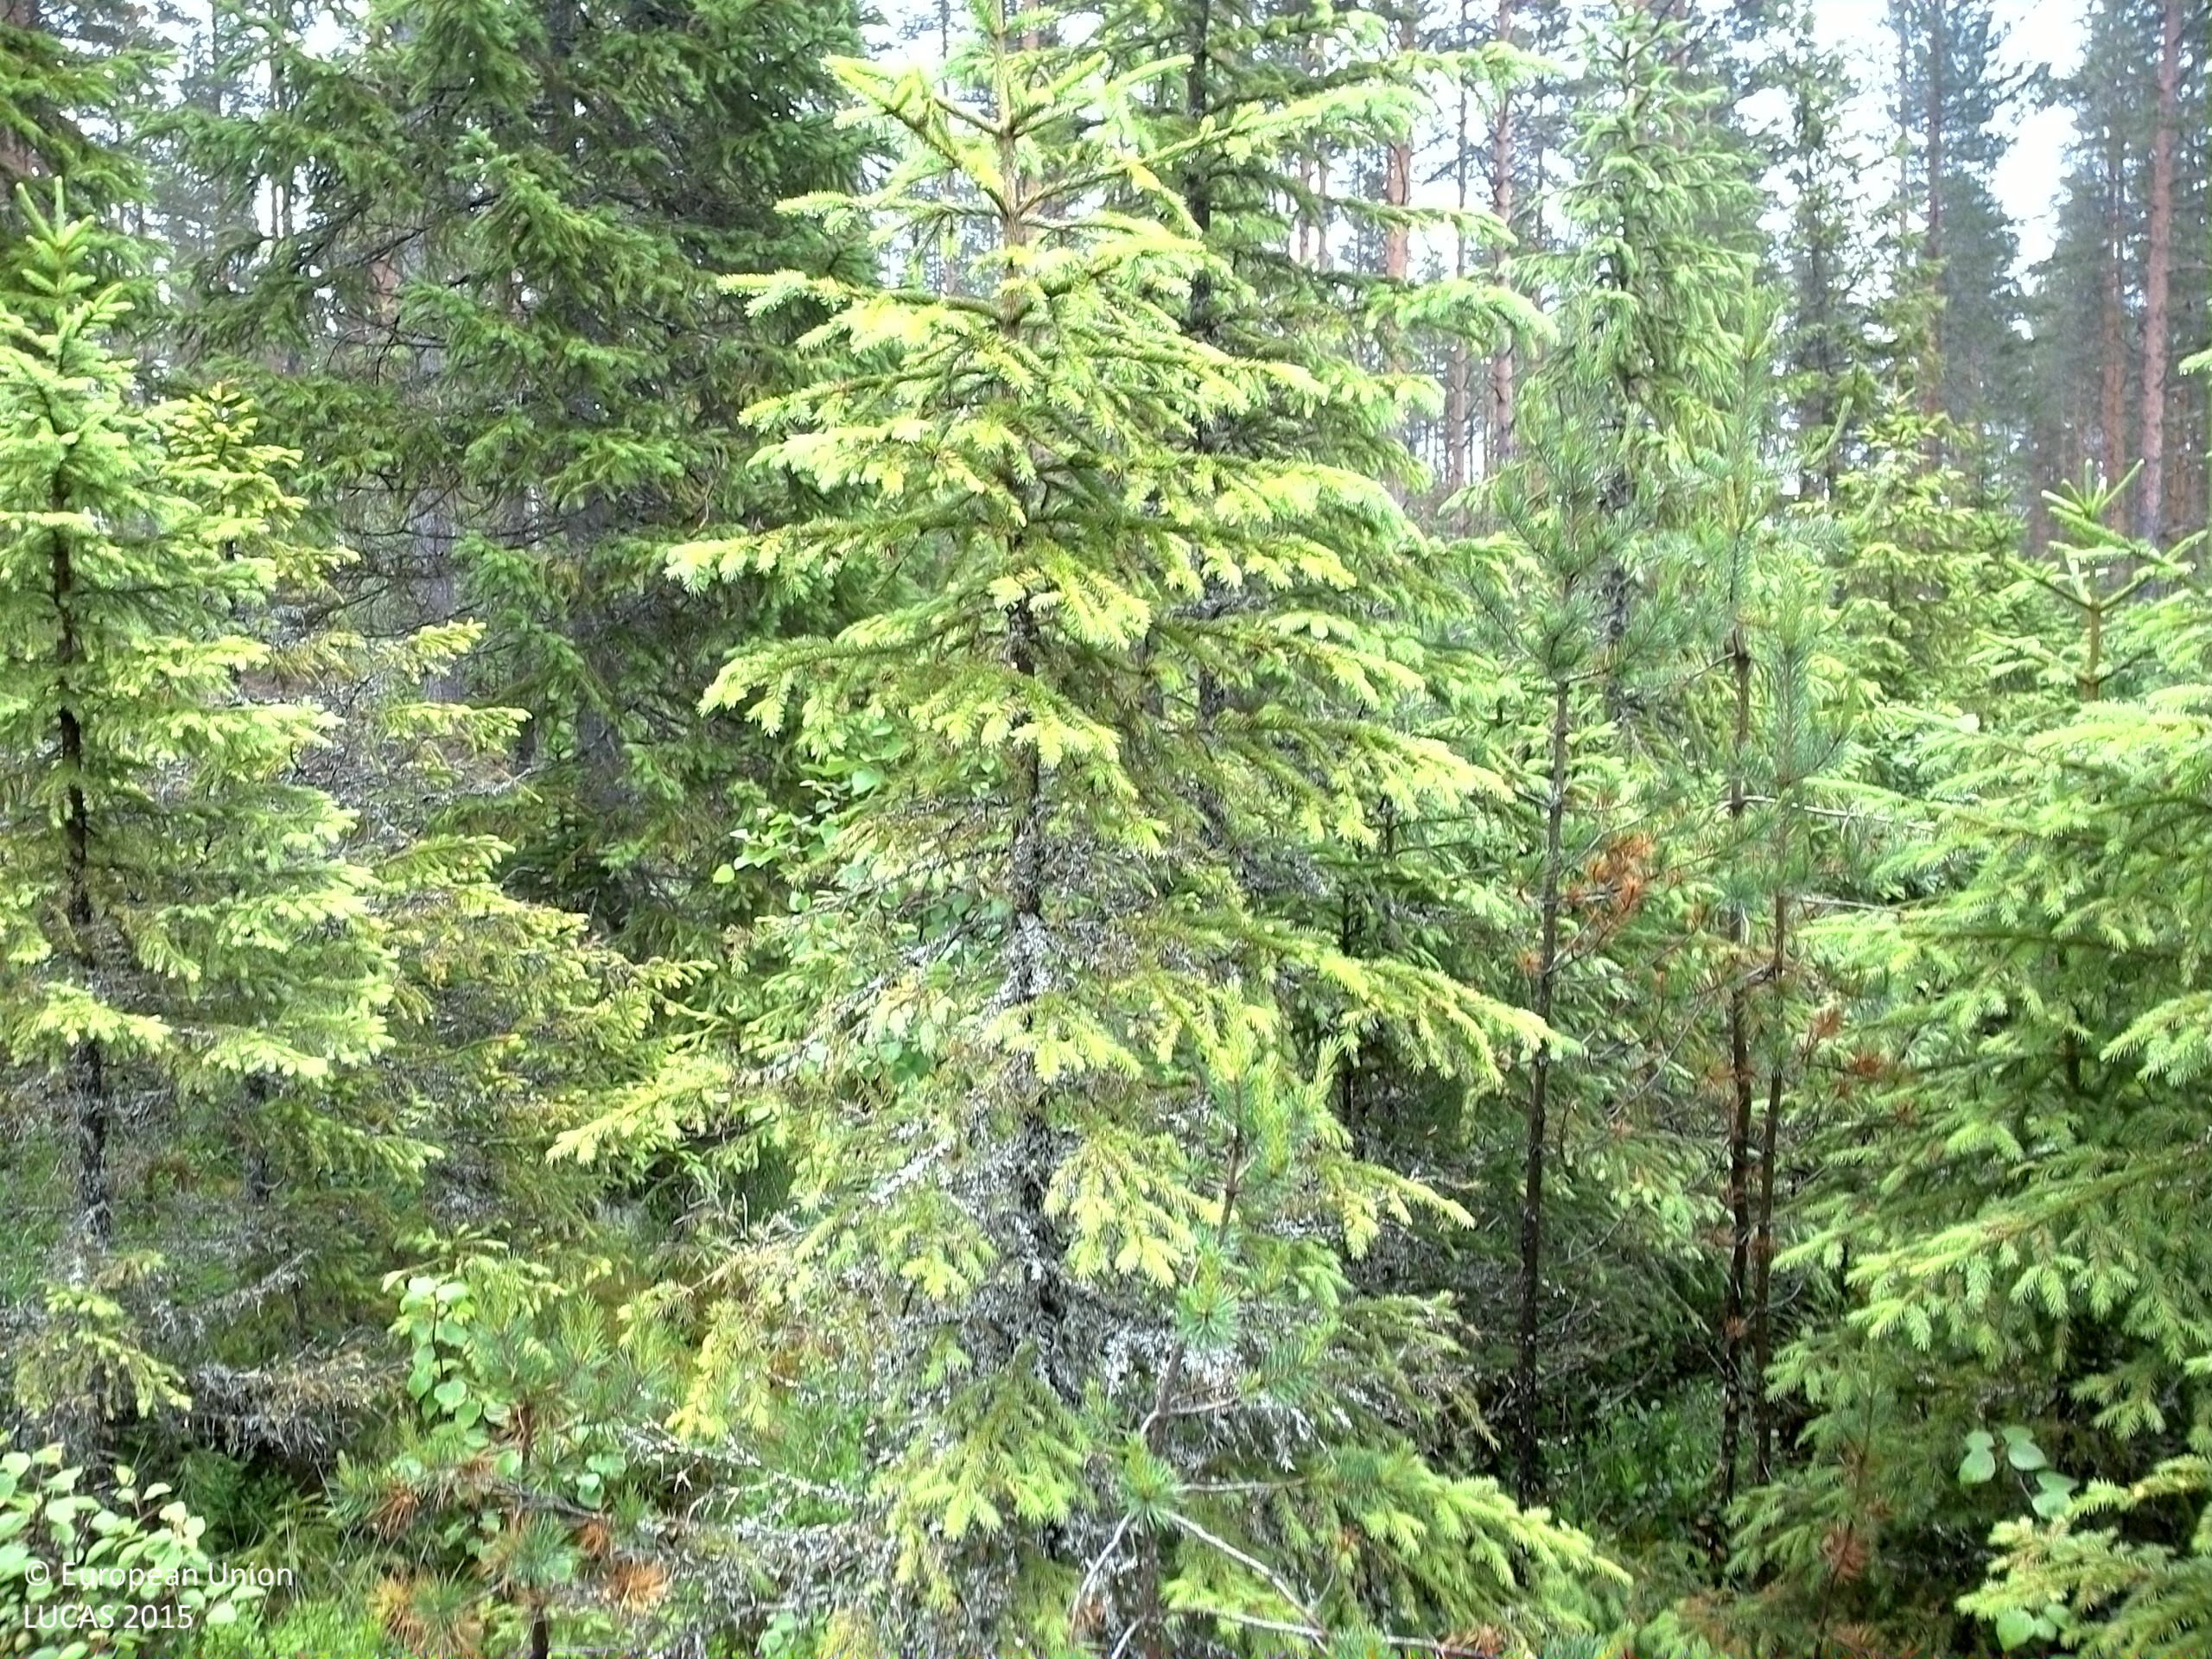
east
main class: Woodland
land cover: Spruce dominated mixed woodland
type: boreal forest
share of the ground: > 75 %
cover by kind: coniferous forest trees 55 %, broadleaved forest trees 30 %, shrubs 15 %
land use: Forestry
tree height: < 5 m
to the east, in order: Spruce dominated mixed woodland; Pine dominated coniferous woodland; Artificial constructions in urban areas; Spruce dominated coniferous woodland; Tracks; Spruce dominated mixed woodland
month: July
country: SE
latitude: 63.6601
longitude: 18.5199
